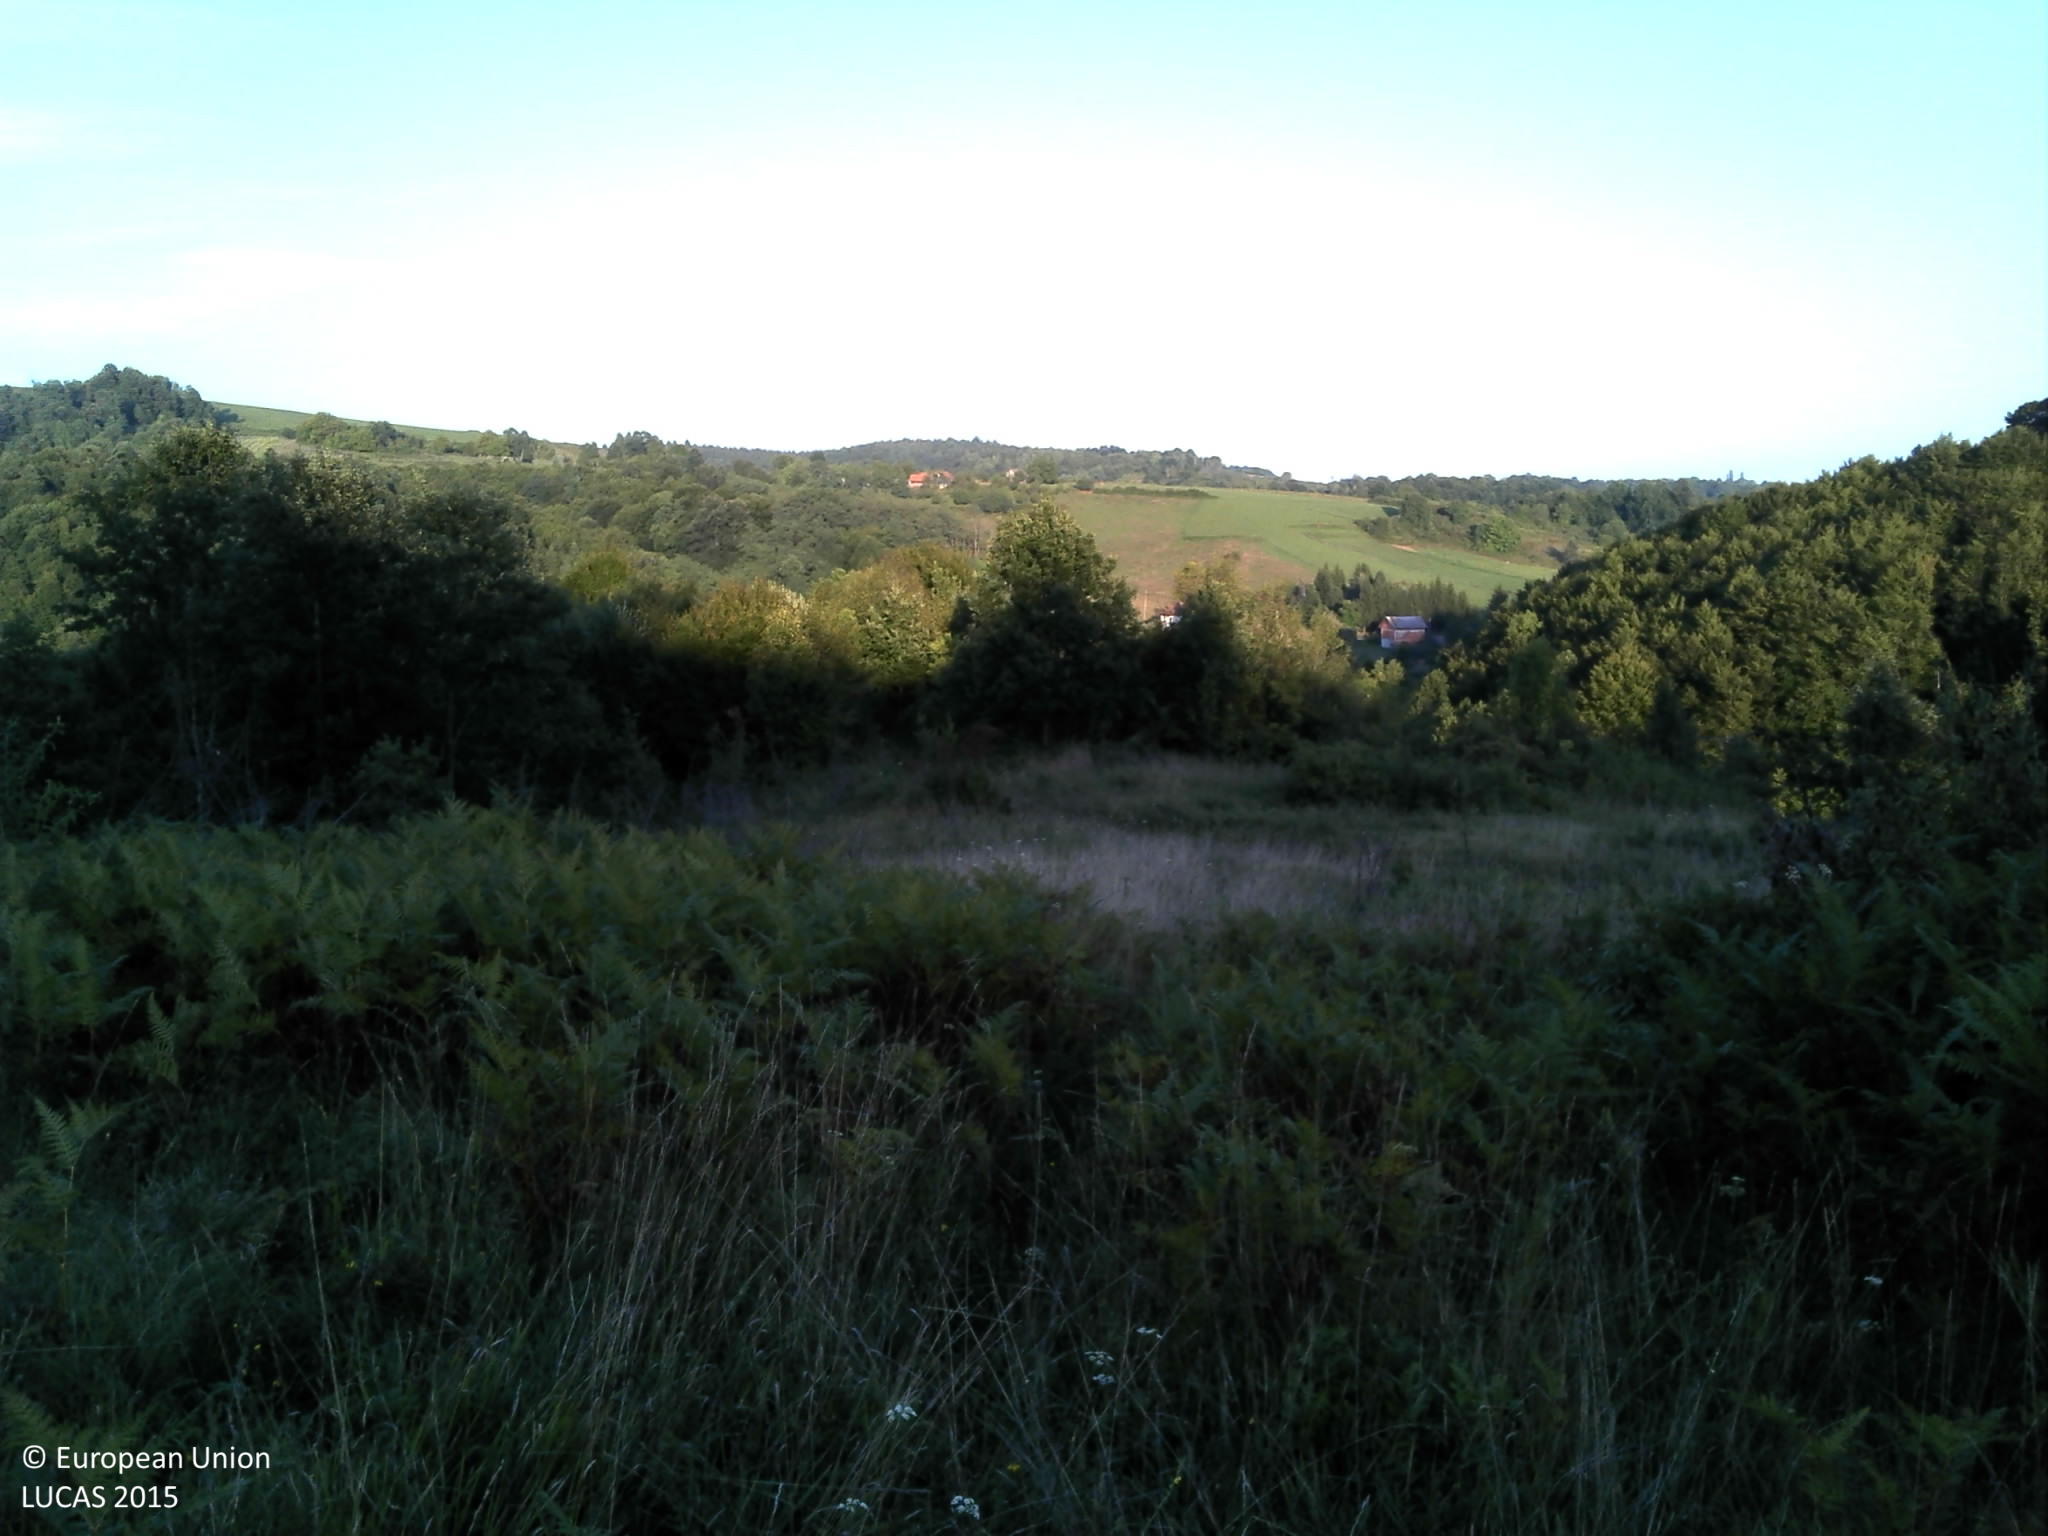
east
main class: Grassland
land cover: Grassland with sparse tree/shrub cover
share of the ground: > 75 %
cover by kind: herbaceous plants 85 %, shrubs 10 %, broadleaved forest trees 5 %
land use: Semi-natural and natural areas not in use
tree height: < 5 m
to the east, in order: Grassland with sparse tree/shrub cover; Broadleaved woodland; Grassland without tree/shrub cover
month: August
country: HR
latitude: 45.2826
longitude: 15.6179
